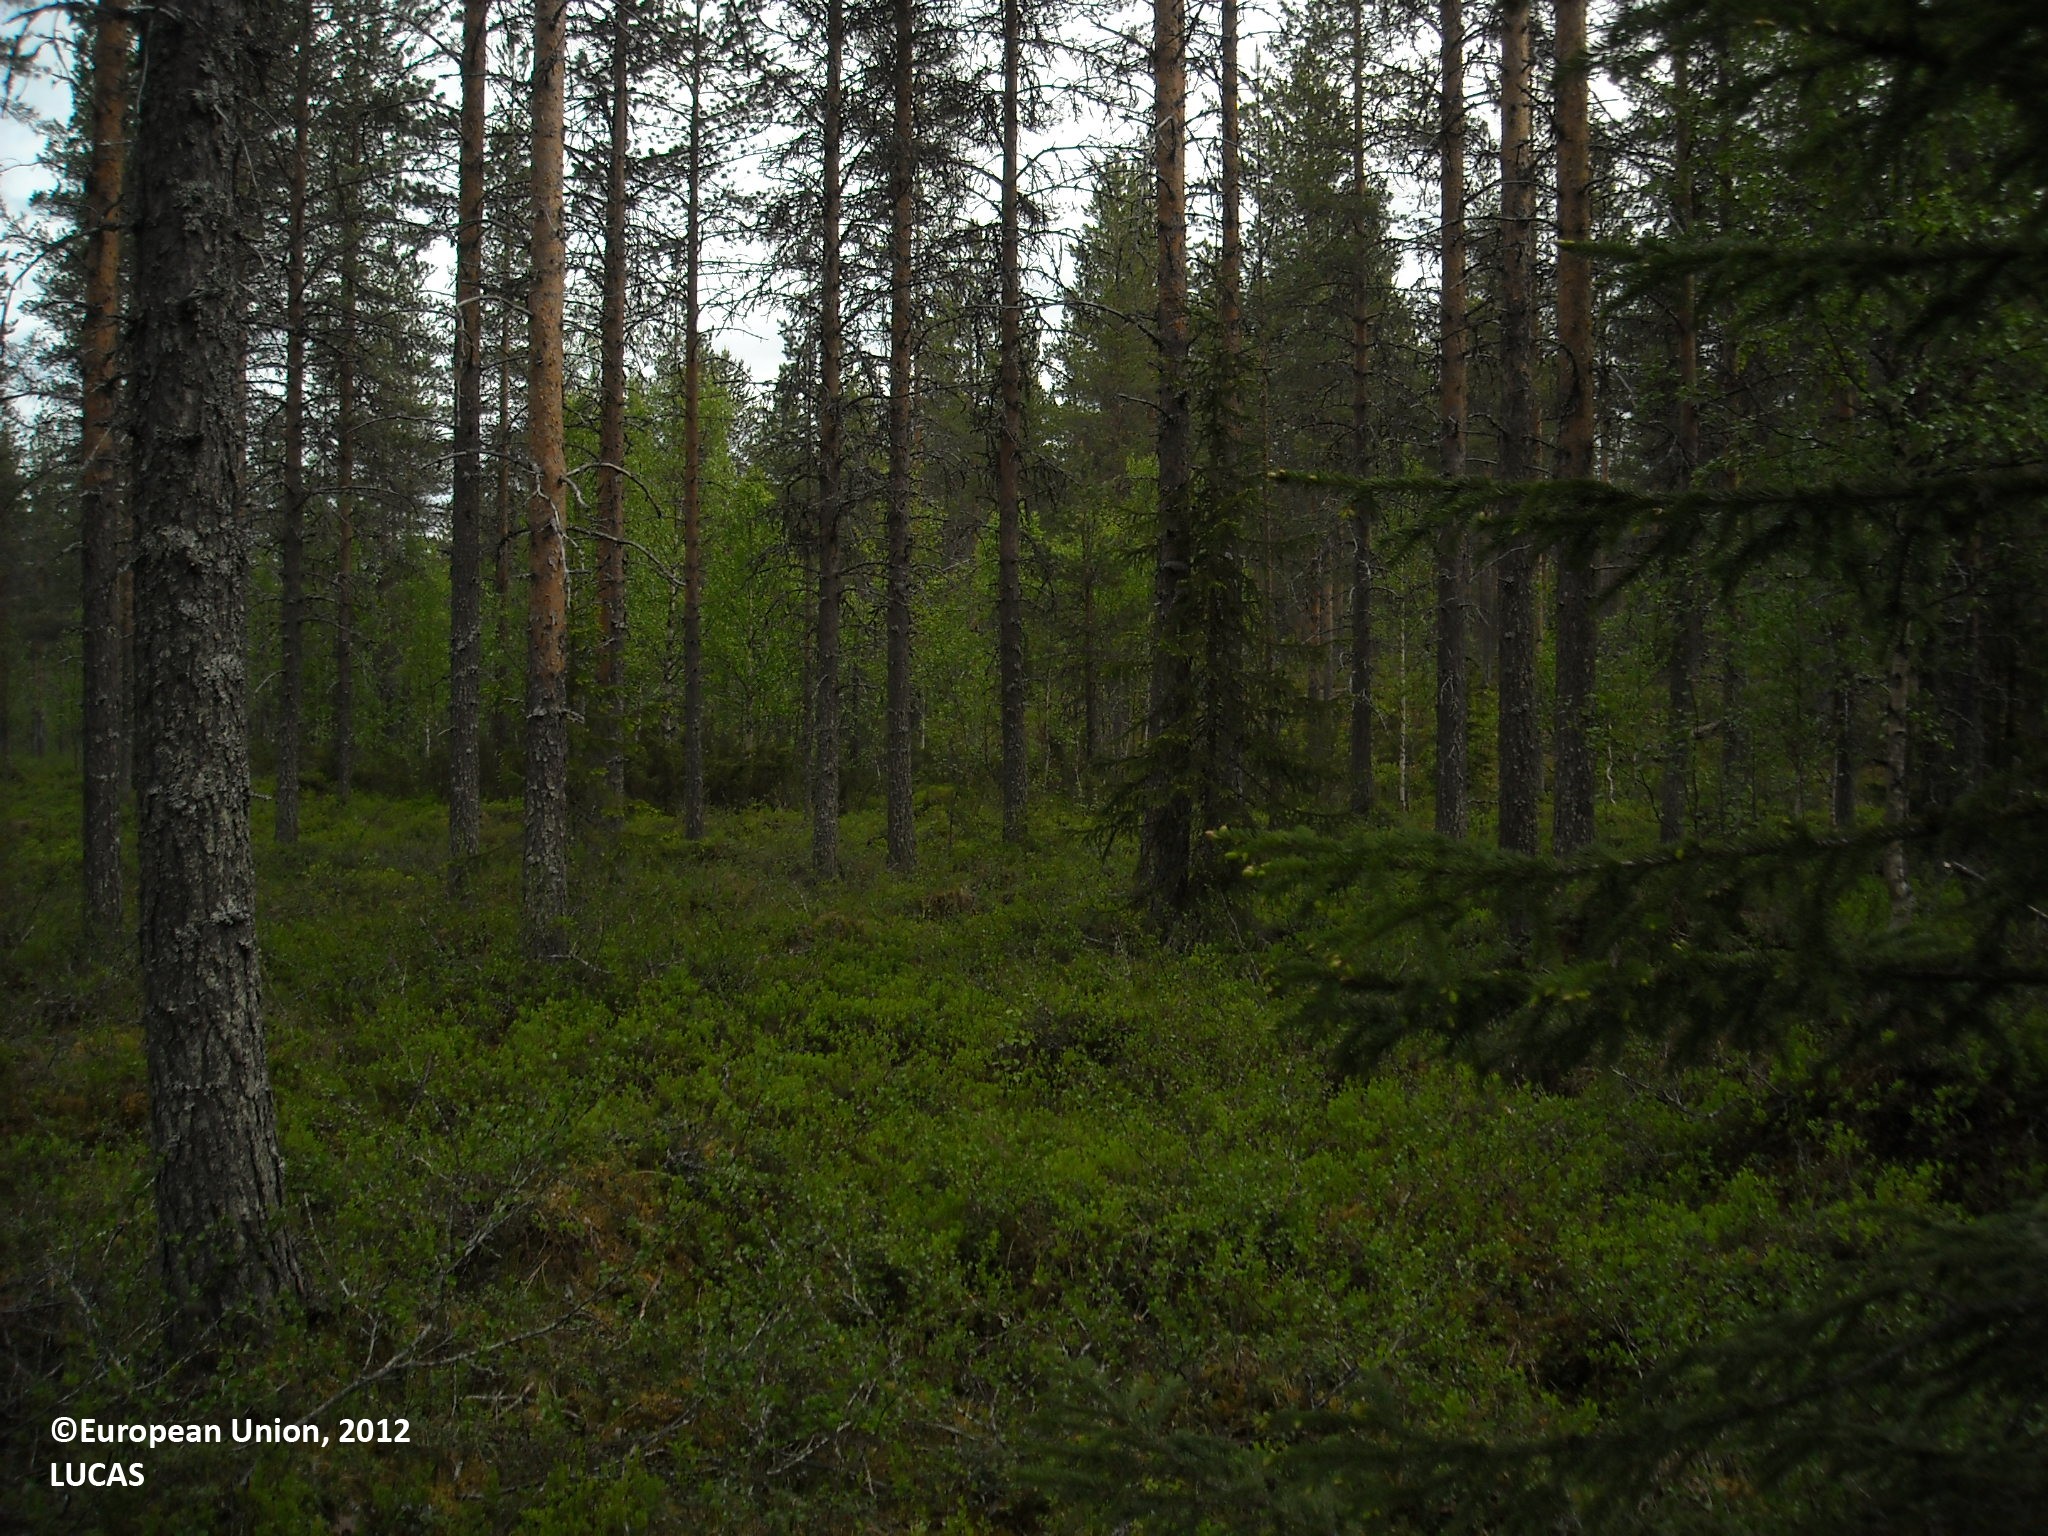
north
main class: Woodland
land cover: Pine dominated coniferous woodland
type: boreal forest
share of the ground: 50 - 75 %
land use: Forestry
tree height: > 5 m
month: June
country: FI
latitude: 65.5897
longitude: 28.0353
